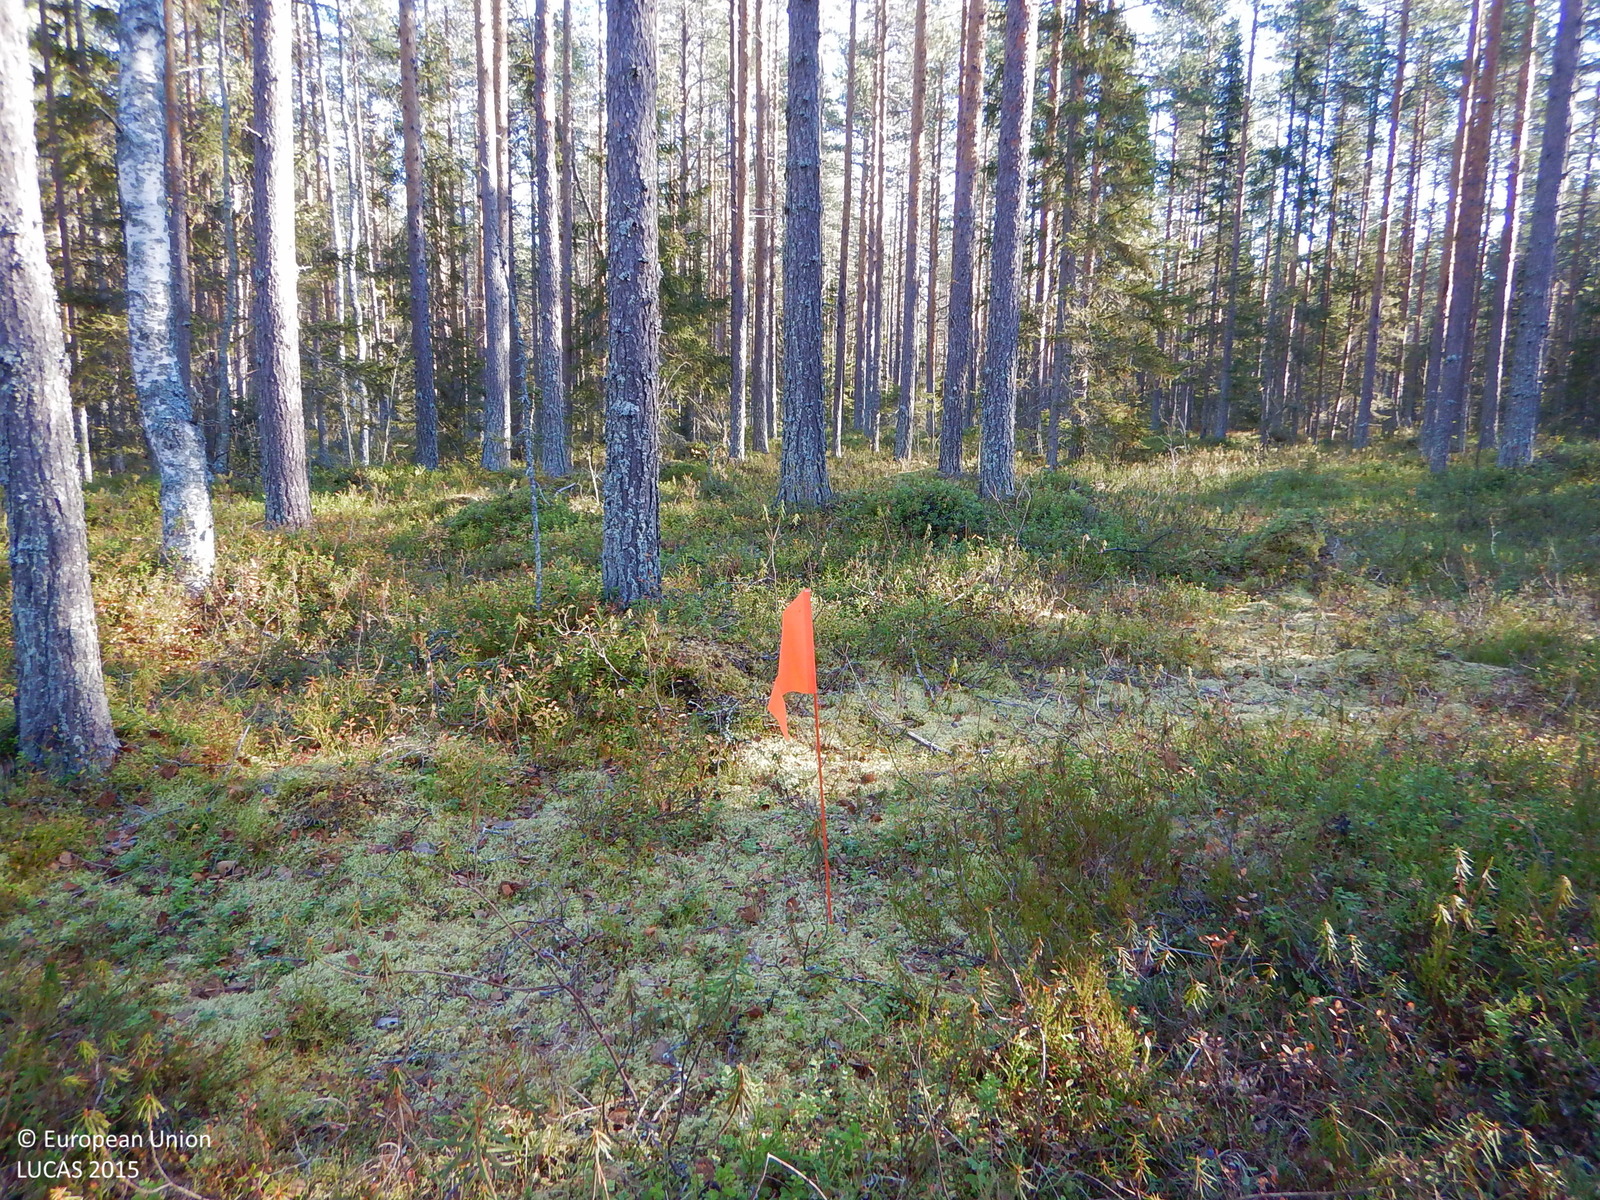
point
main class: Woodland
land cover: Pine dominated coniferous woodland
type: boreal forest
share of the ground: 50 - 75 %
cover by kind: coniferous forest trees 60 %, shrubs 15 %, lichens and mosses 15 %, broadleaved forest trees 5 %, herbaceous plants 5 %
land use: Forestry
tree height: > 5 m
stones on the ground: < 10 %
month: October
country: SE
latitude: 65.0476
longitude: 21.1296
